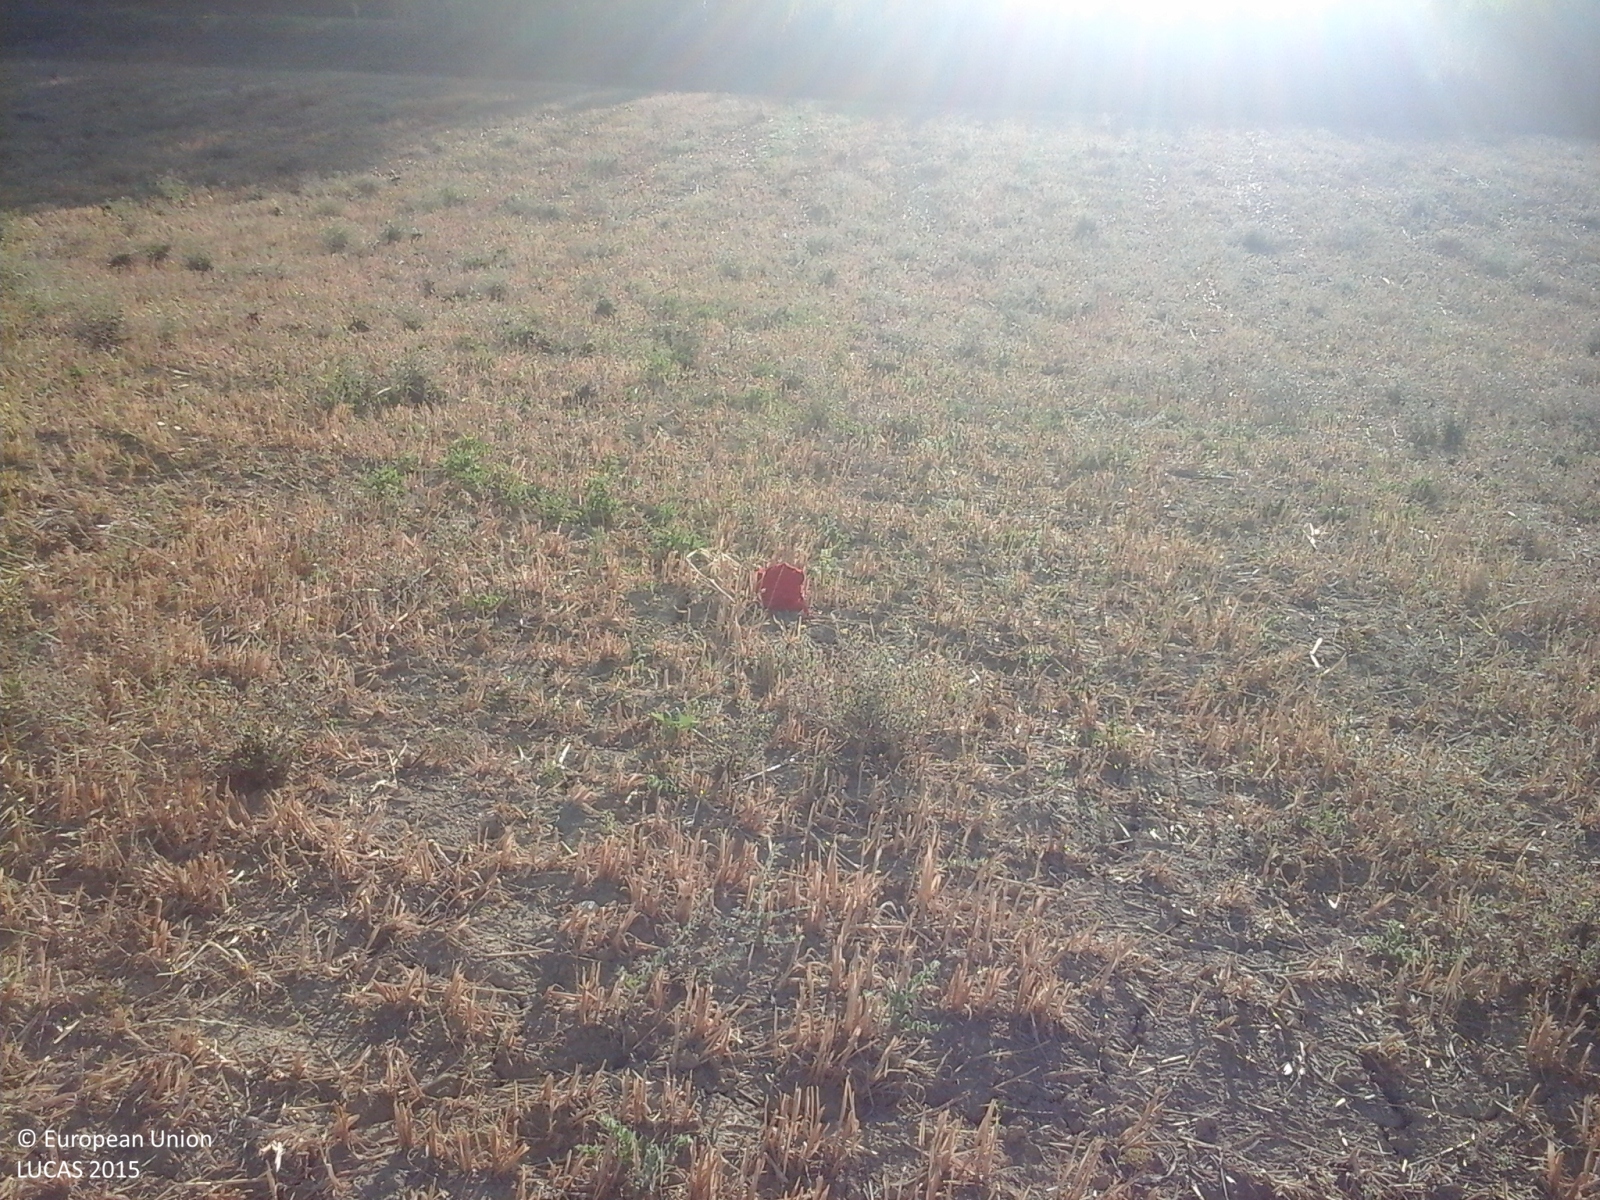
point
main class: Cropland
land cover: Oats
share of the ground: > 75 %
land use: Agriculture (excluding fallow land and kitchen gardens)
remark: Harvested field
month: July
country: IT
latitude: 42.3208
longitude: 14.0281
